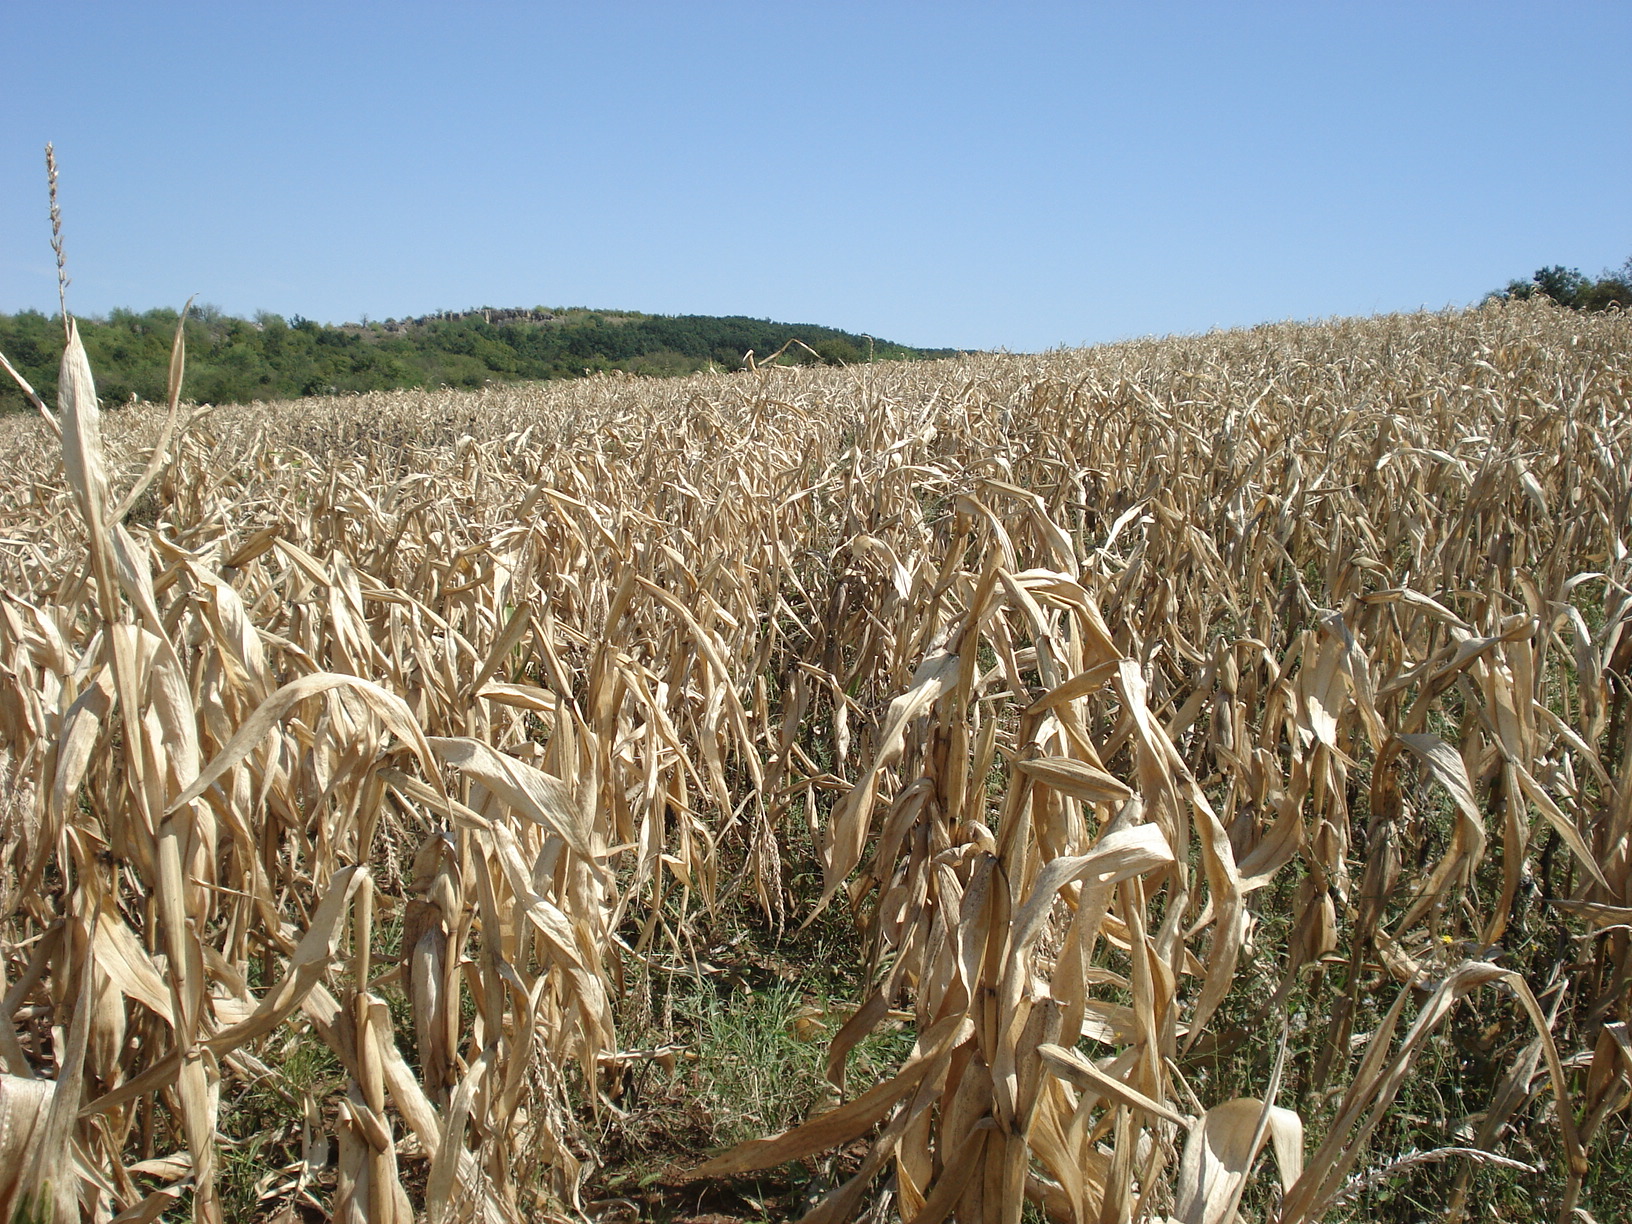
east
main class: Cropland
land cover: Maize
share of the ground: > 75 %
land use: Agriculture (excluding fallow land and kitchen gardens)
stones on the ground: < 10 %
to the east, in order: Maize; Grassland with sparse tree/shrub cover
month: September
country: BG
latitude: 43.1478
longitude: 25.3338
